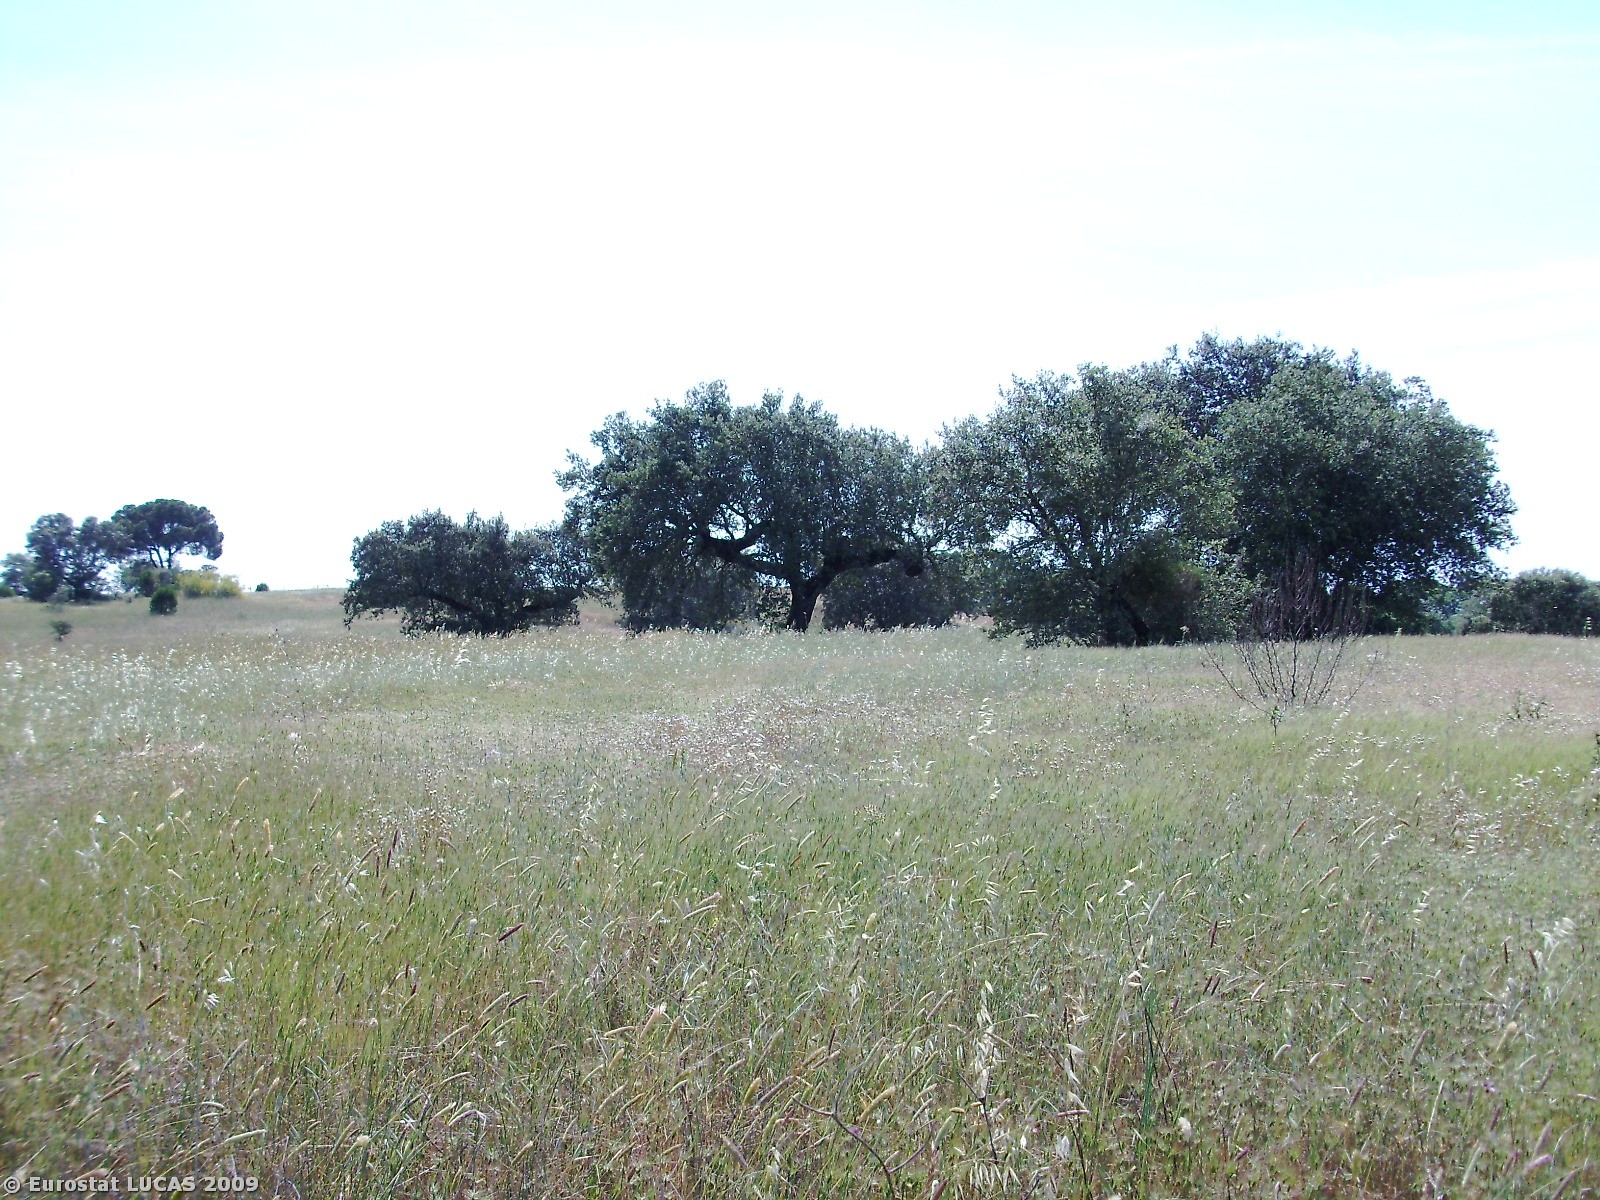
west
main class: Grassland
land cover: Grassland with sparse tree/shrub cover
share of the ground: > 75 %
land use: Agriculture (excluding fallow land and kitchen gardens)
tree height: > 5 m
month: May
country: PT
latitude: 38.9669
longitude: -8.0433
